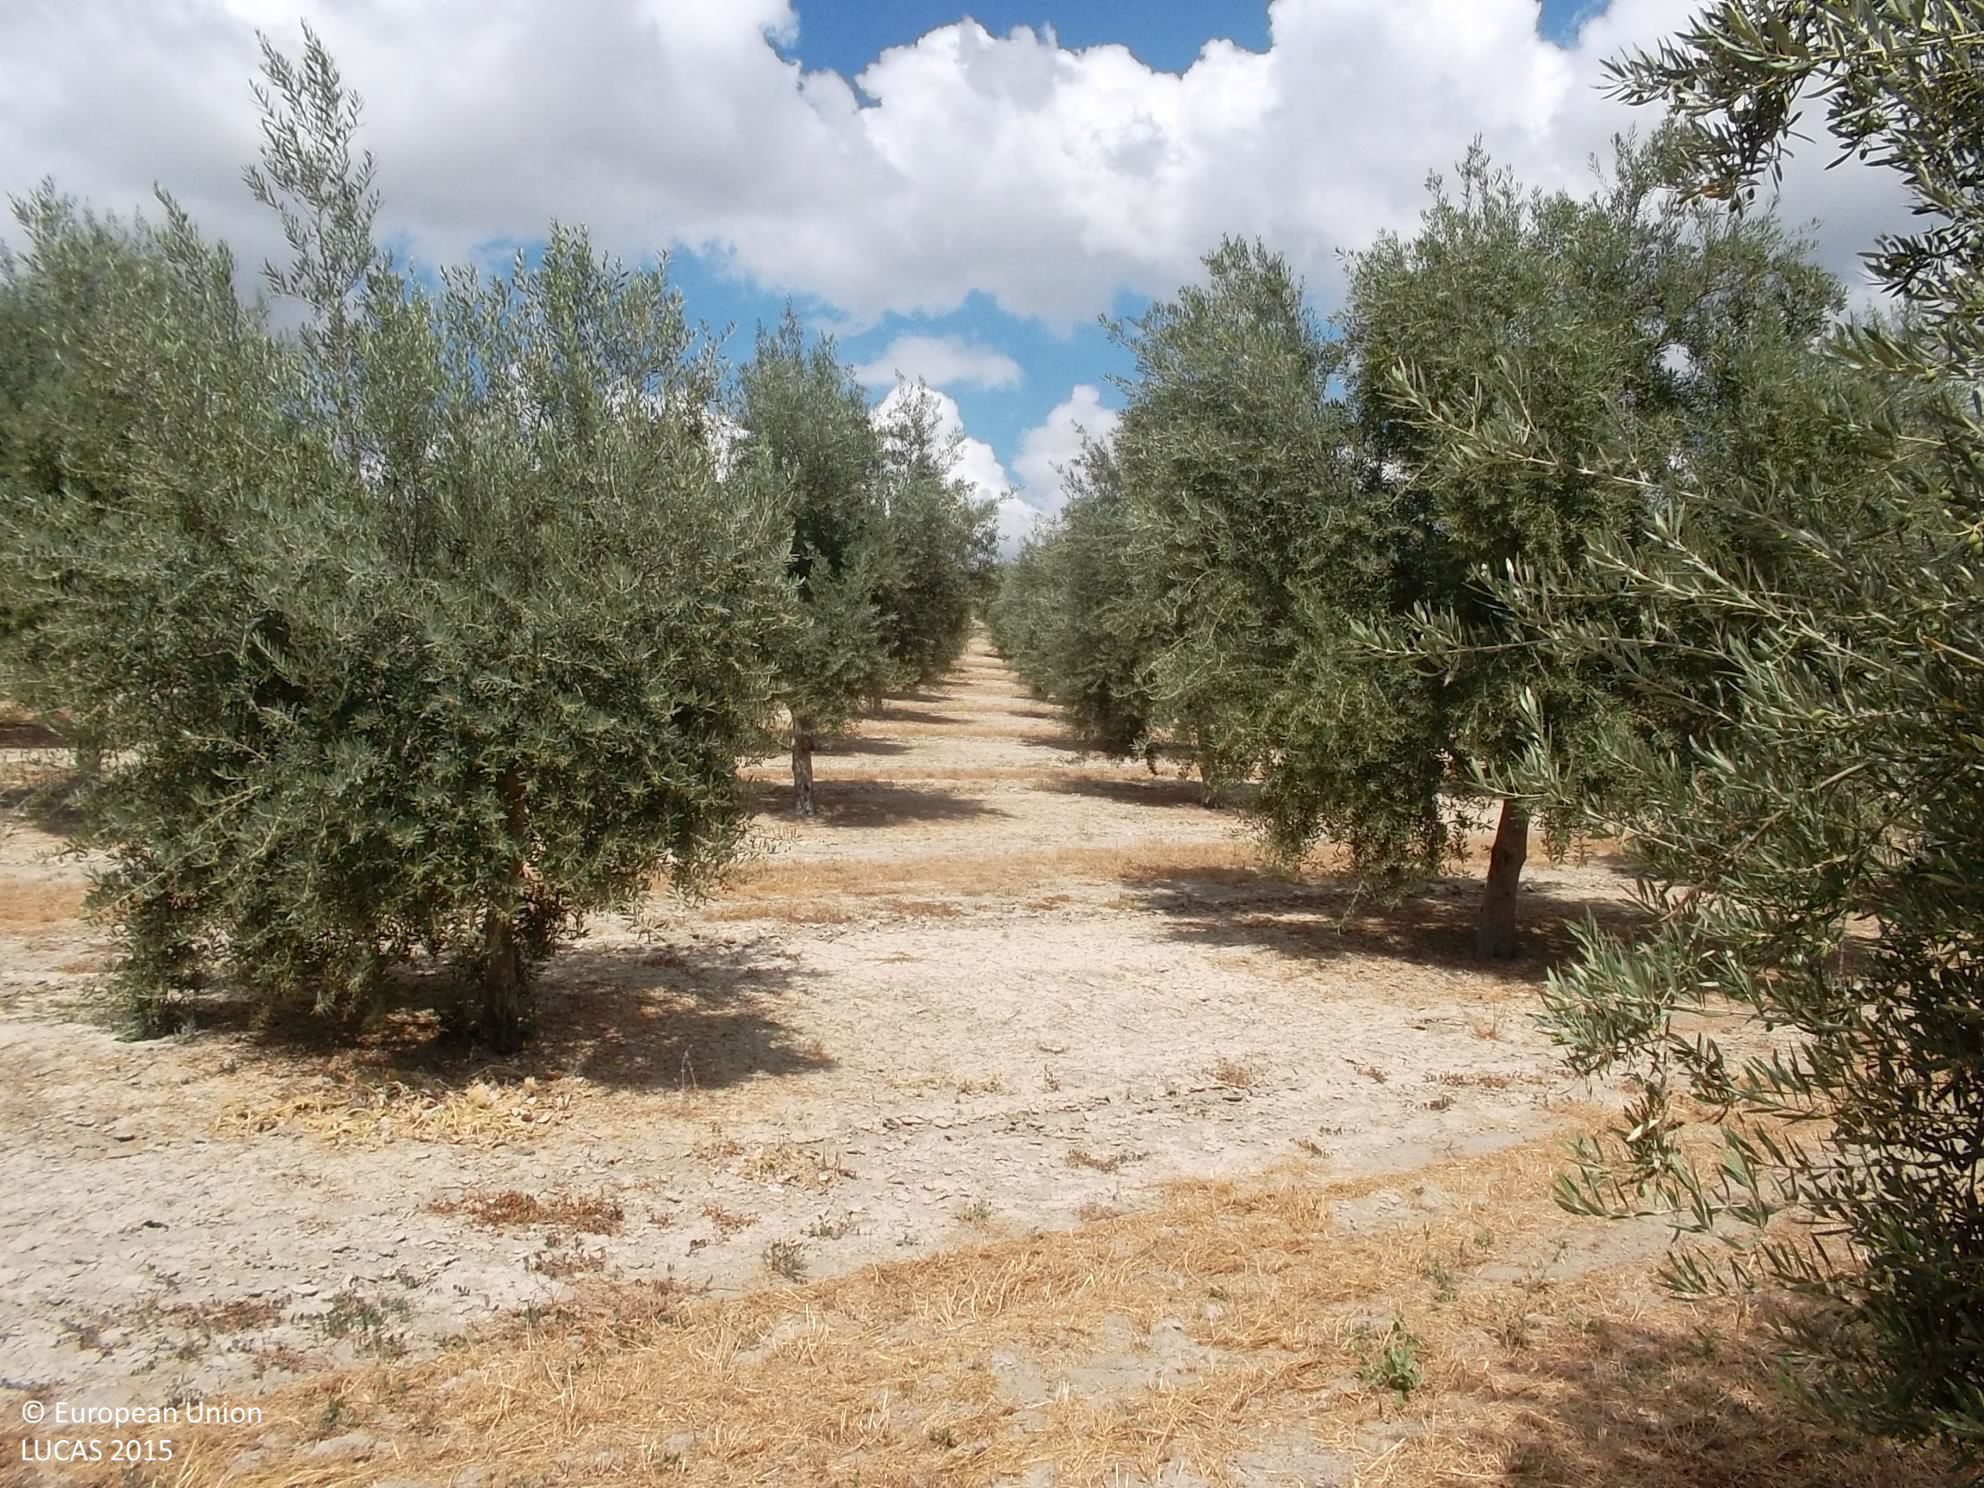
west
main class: Cropland
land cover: Olive groves
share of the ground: 50 - 75 %
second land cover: Other bare soil
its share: > 75 %
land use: Agriculture (excluding fallow land and kitchen gardens)
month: June
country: ES
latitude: 37.9556
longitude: -3.2341
